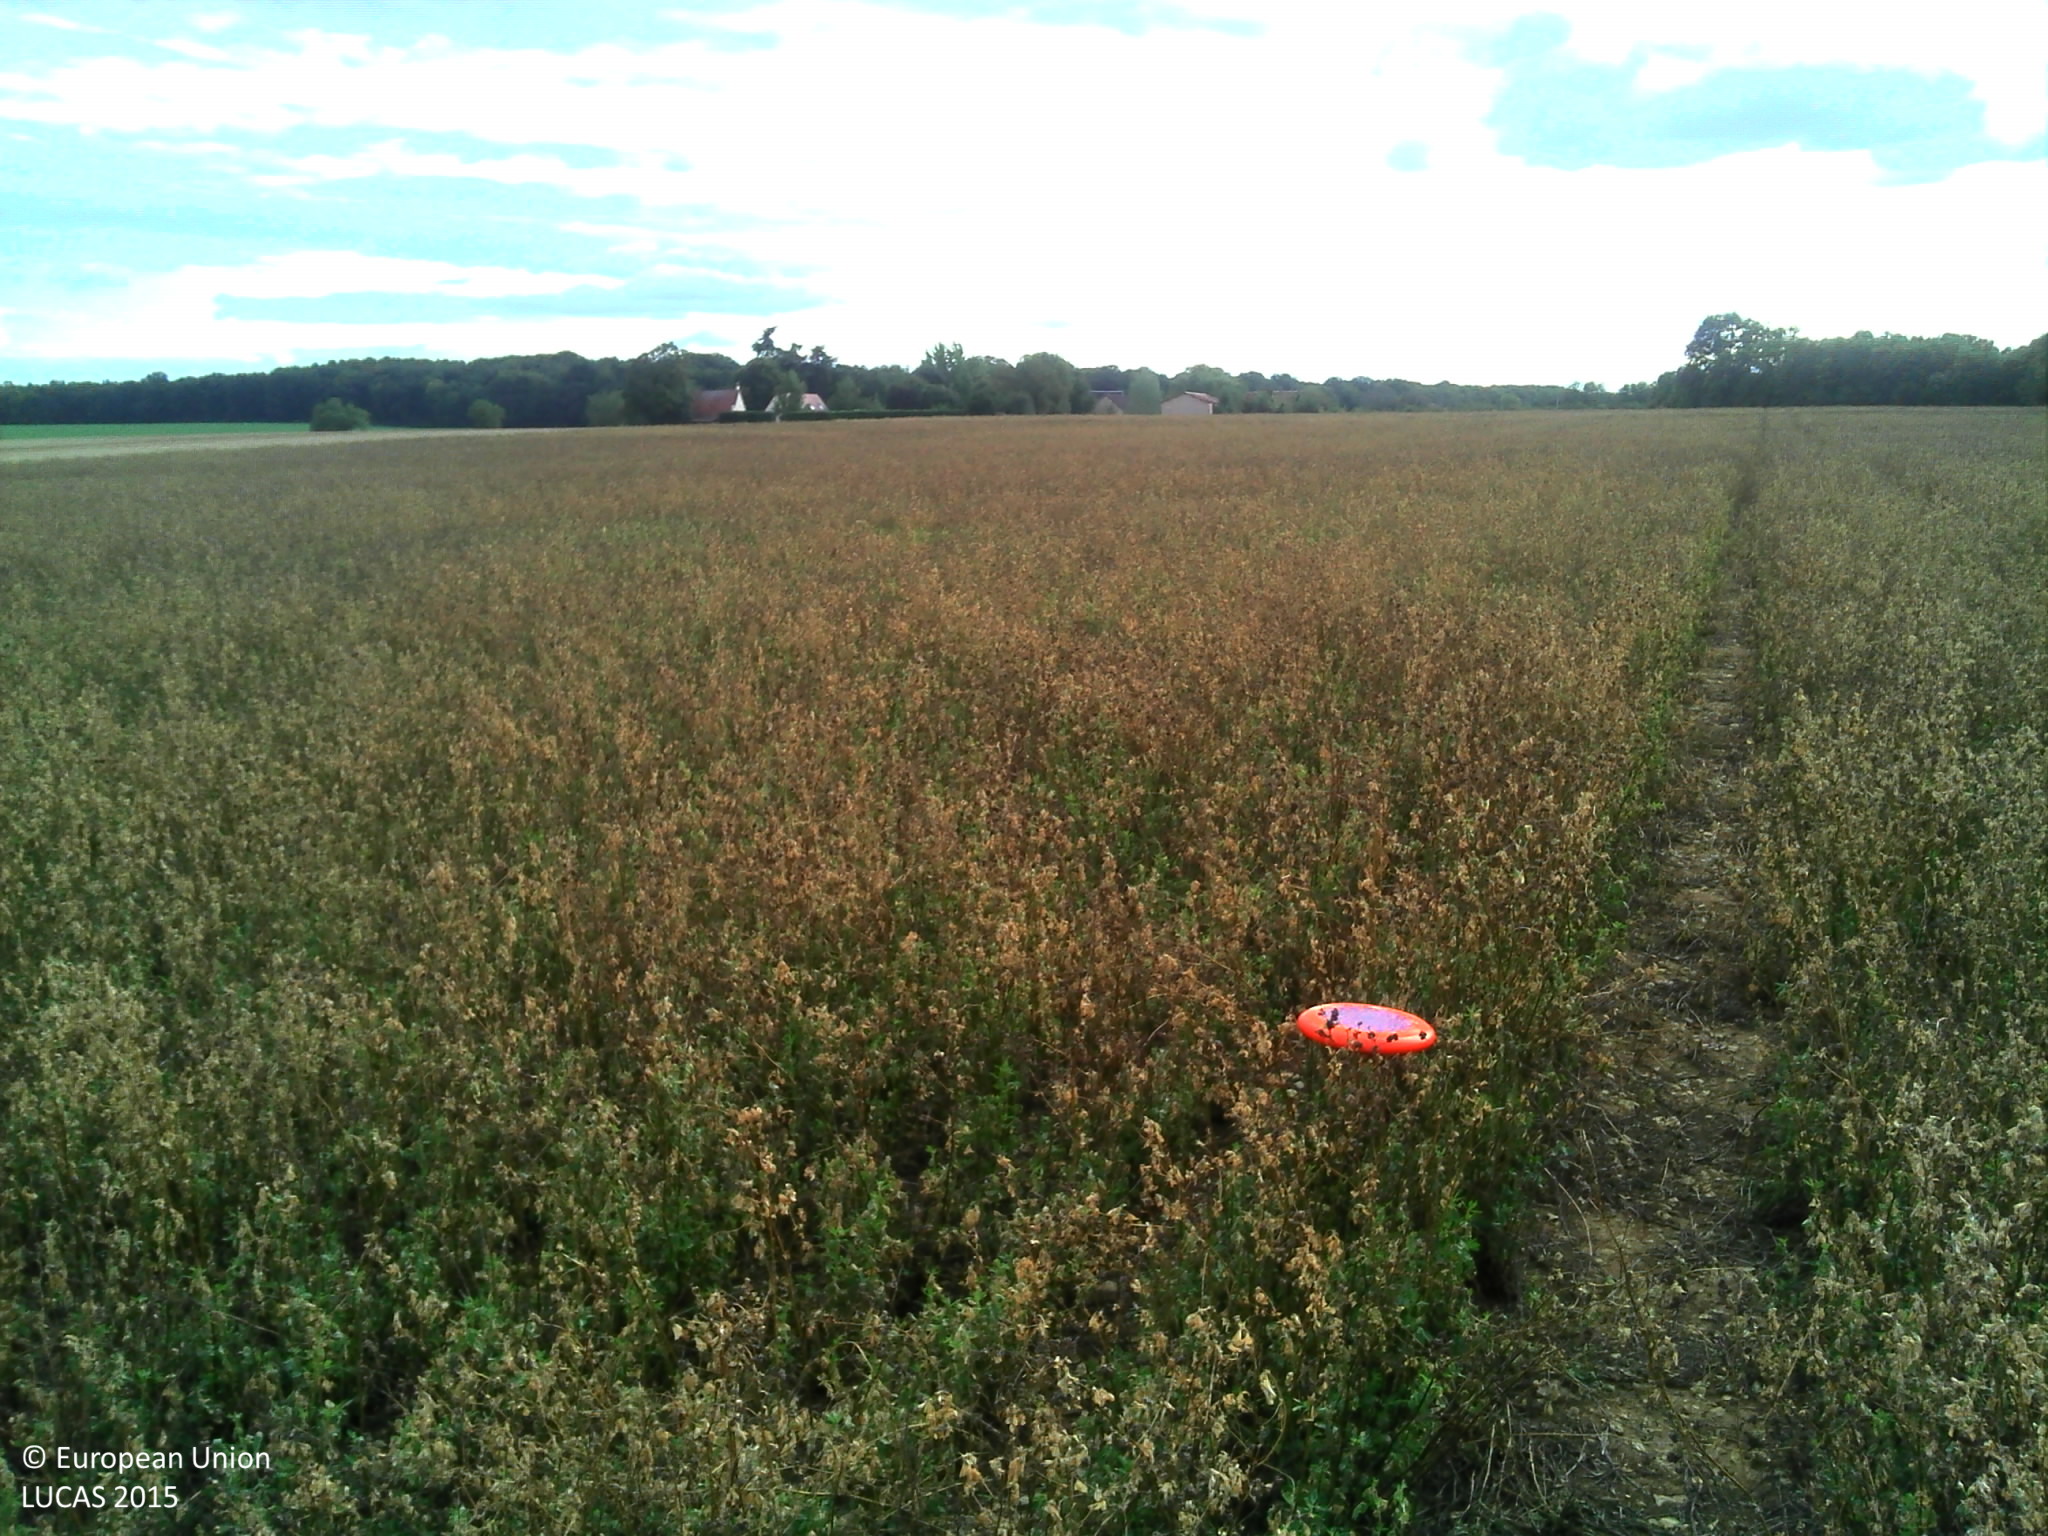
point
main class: Cropland
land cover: Lucerne
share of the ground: > 75 %
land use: Agriculture (excluding fallow land and kitchen gardens)
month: September
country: FR
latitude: 46.8833
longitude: 1.5243
